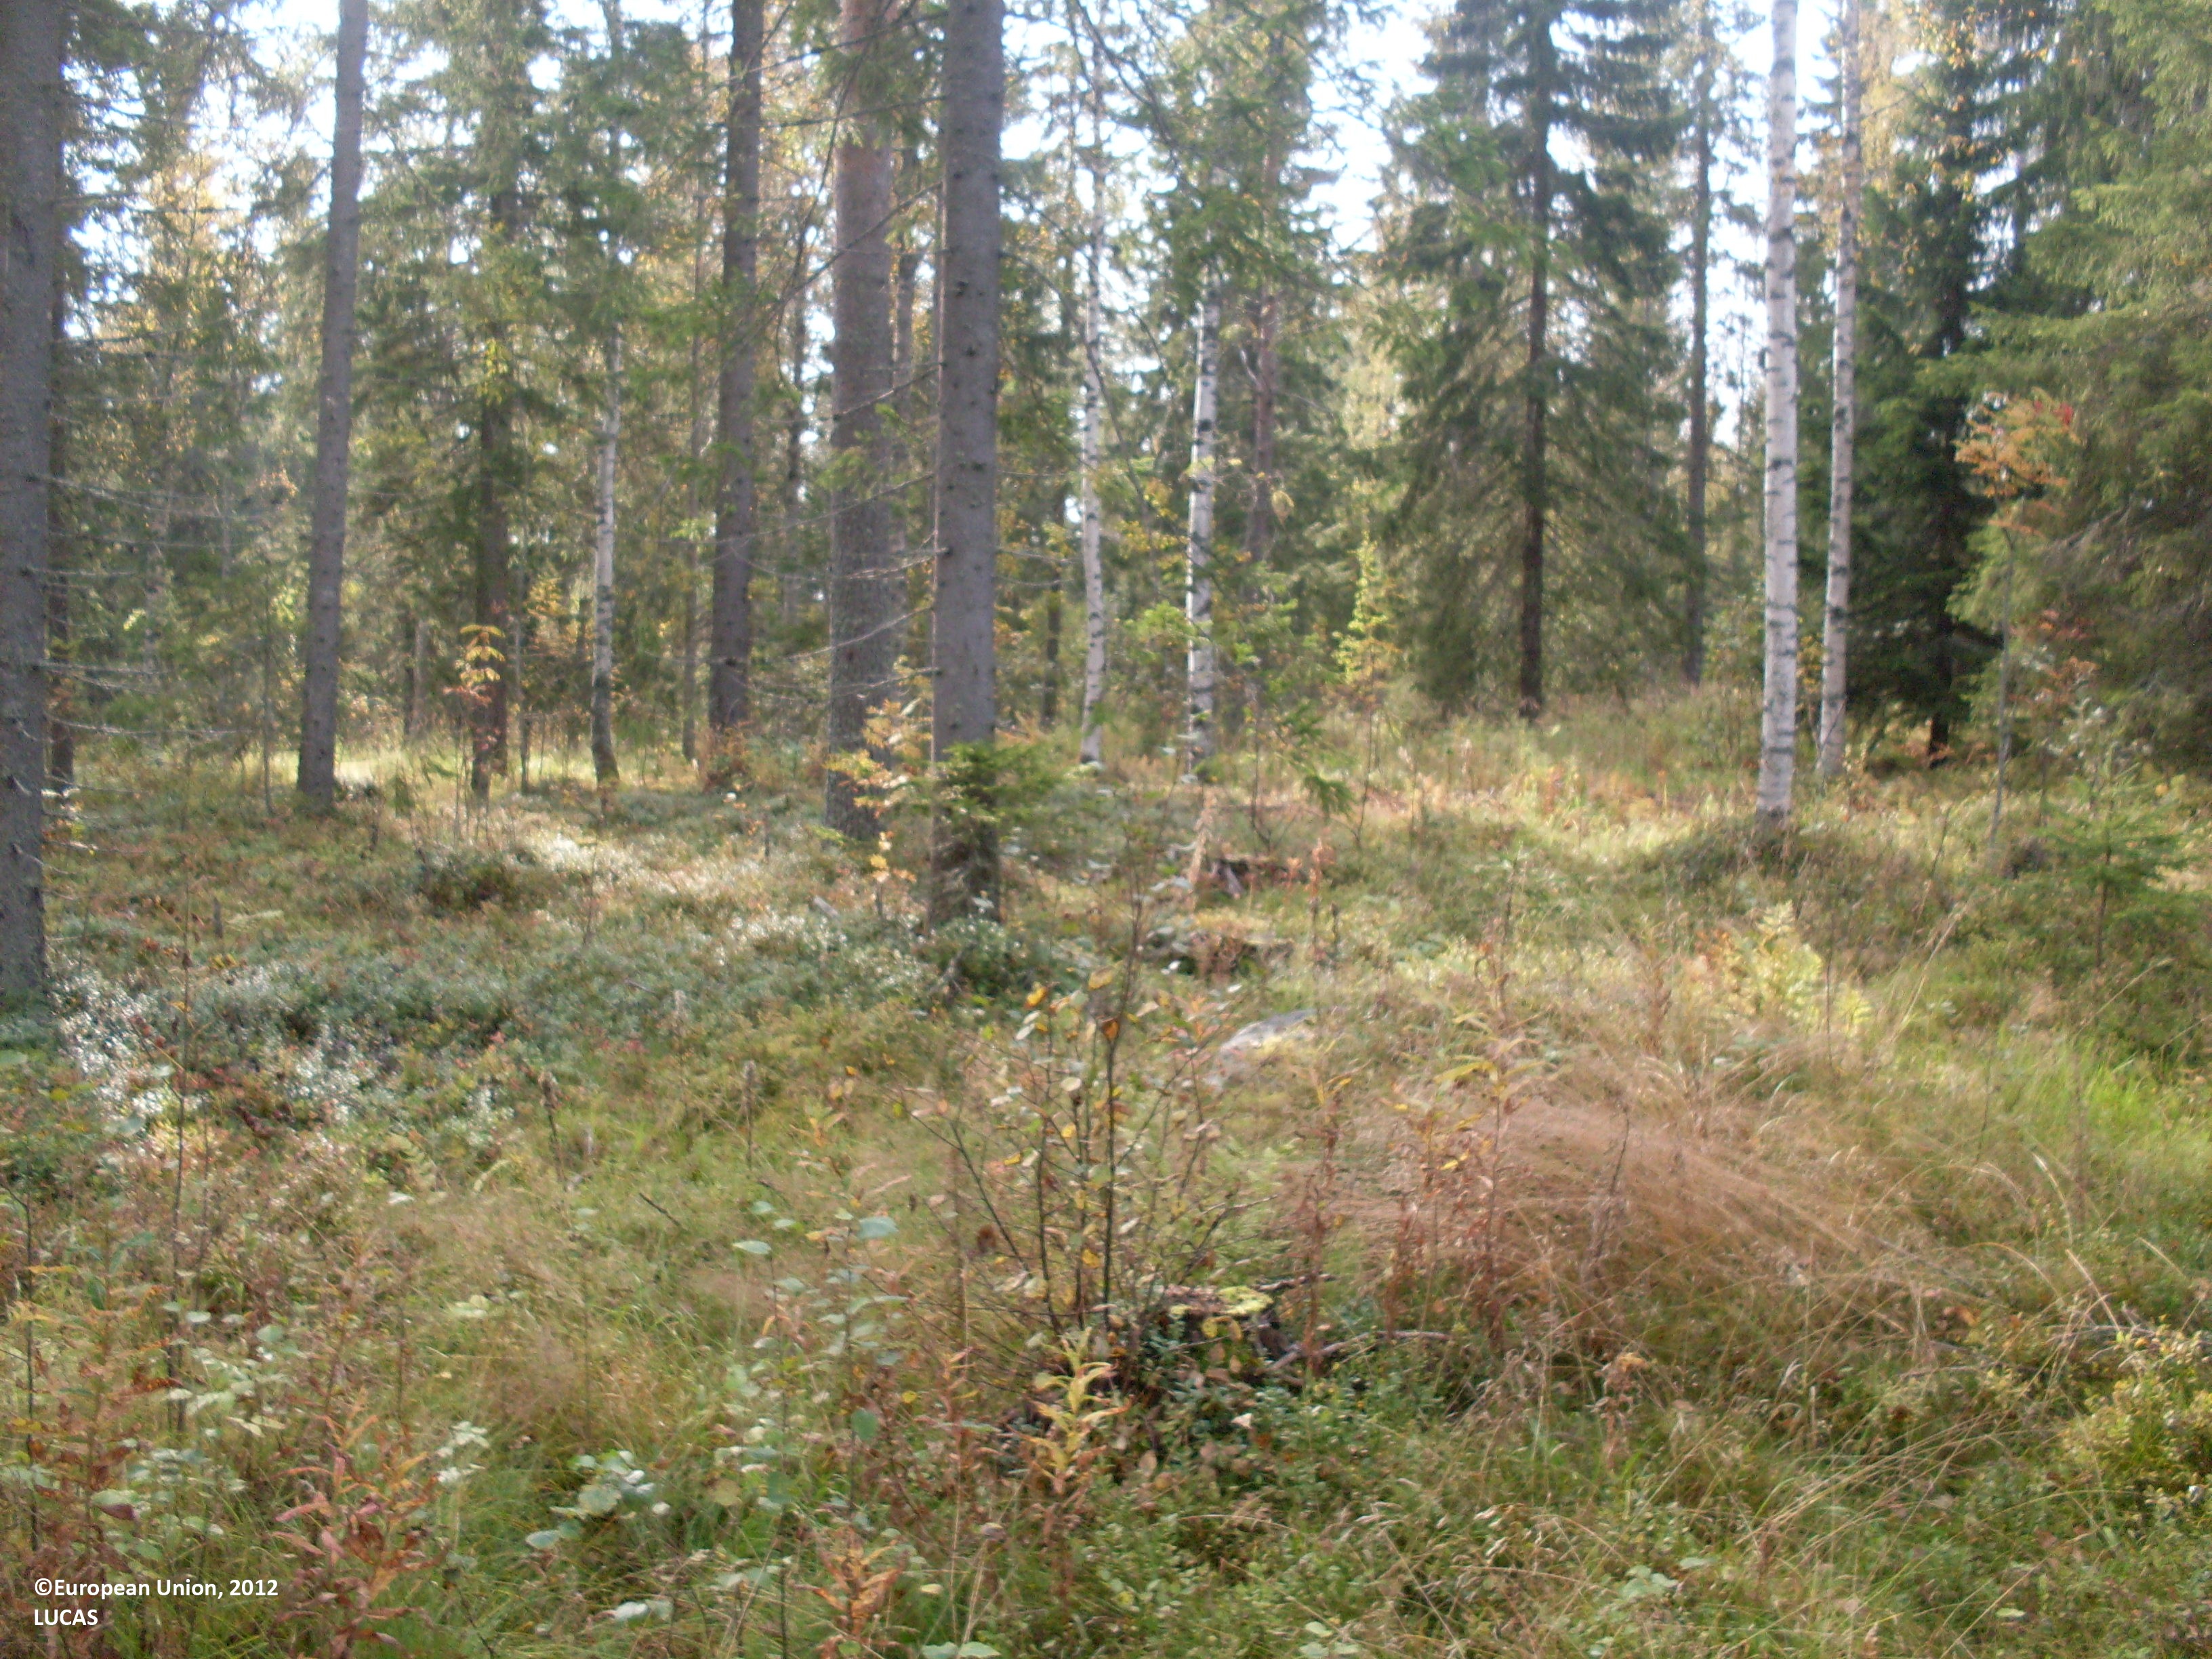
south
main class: Woodland
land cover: Other mixed woodland
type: boreal forest
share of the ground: 50 - 75 %
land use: Forestry
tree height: > 5 m
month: September
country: FI
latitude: 64.2341
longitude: 29.3665
